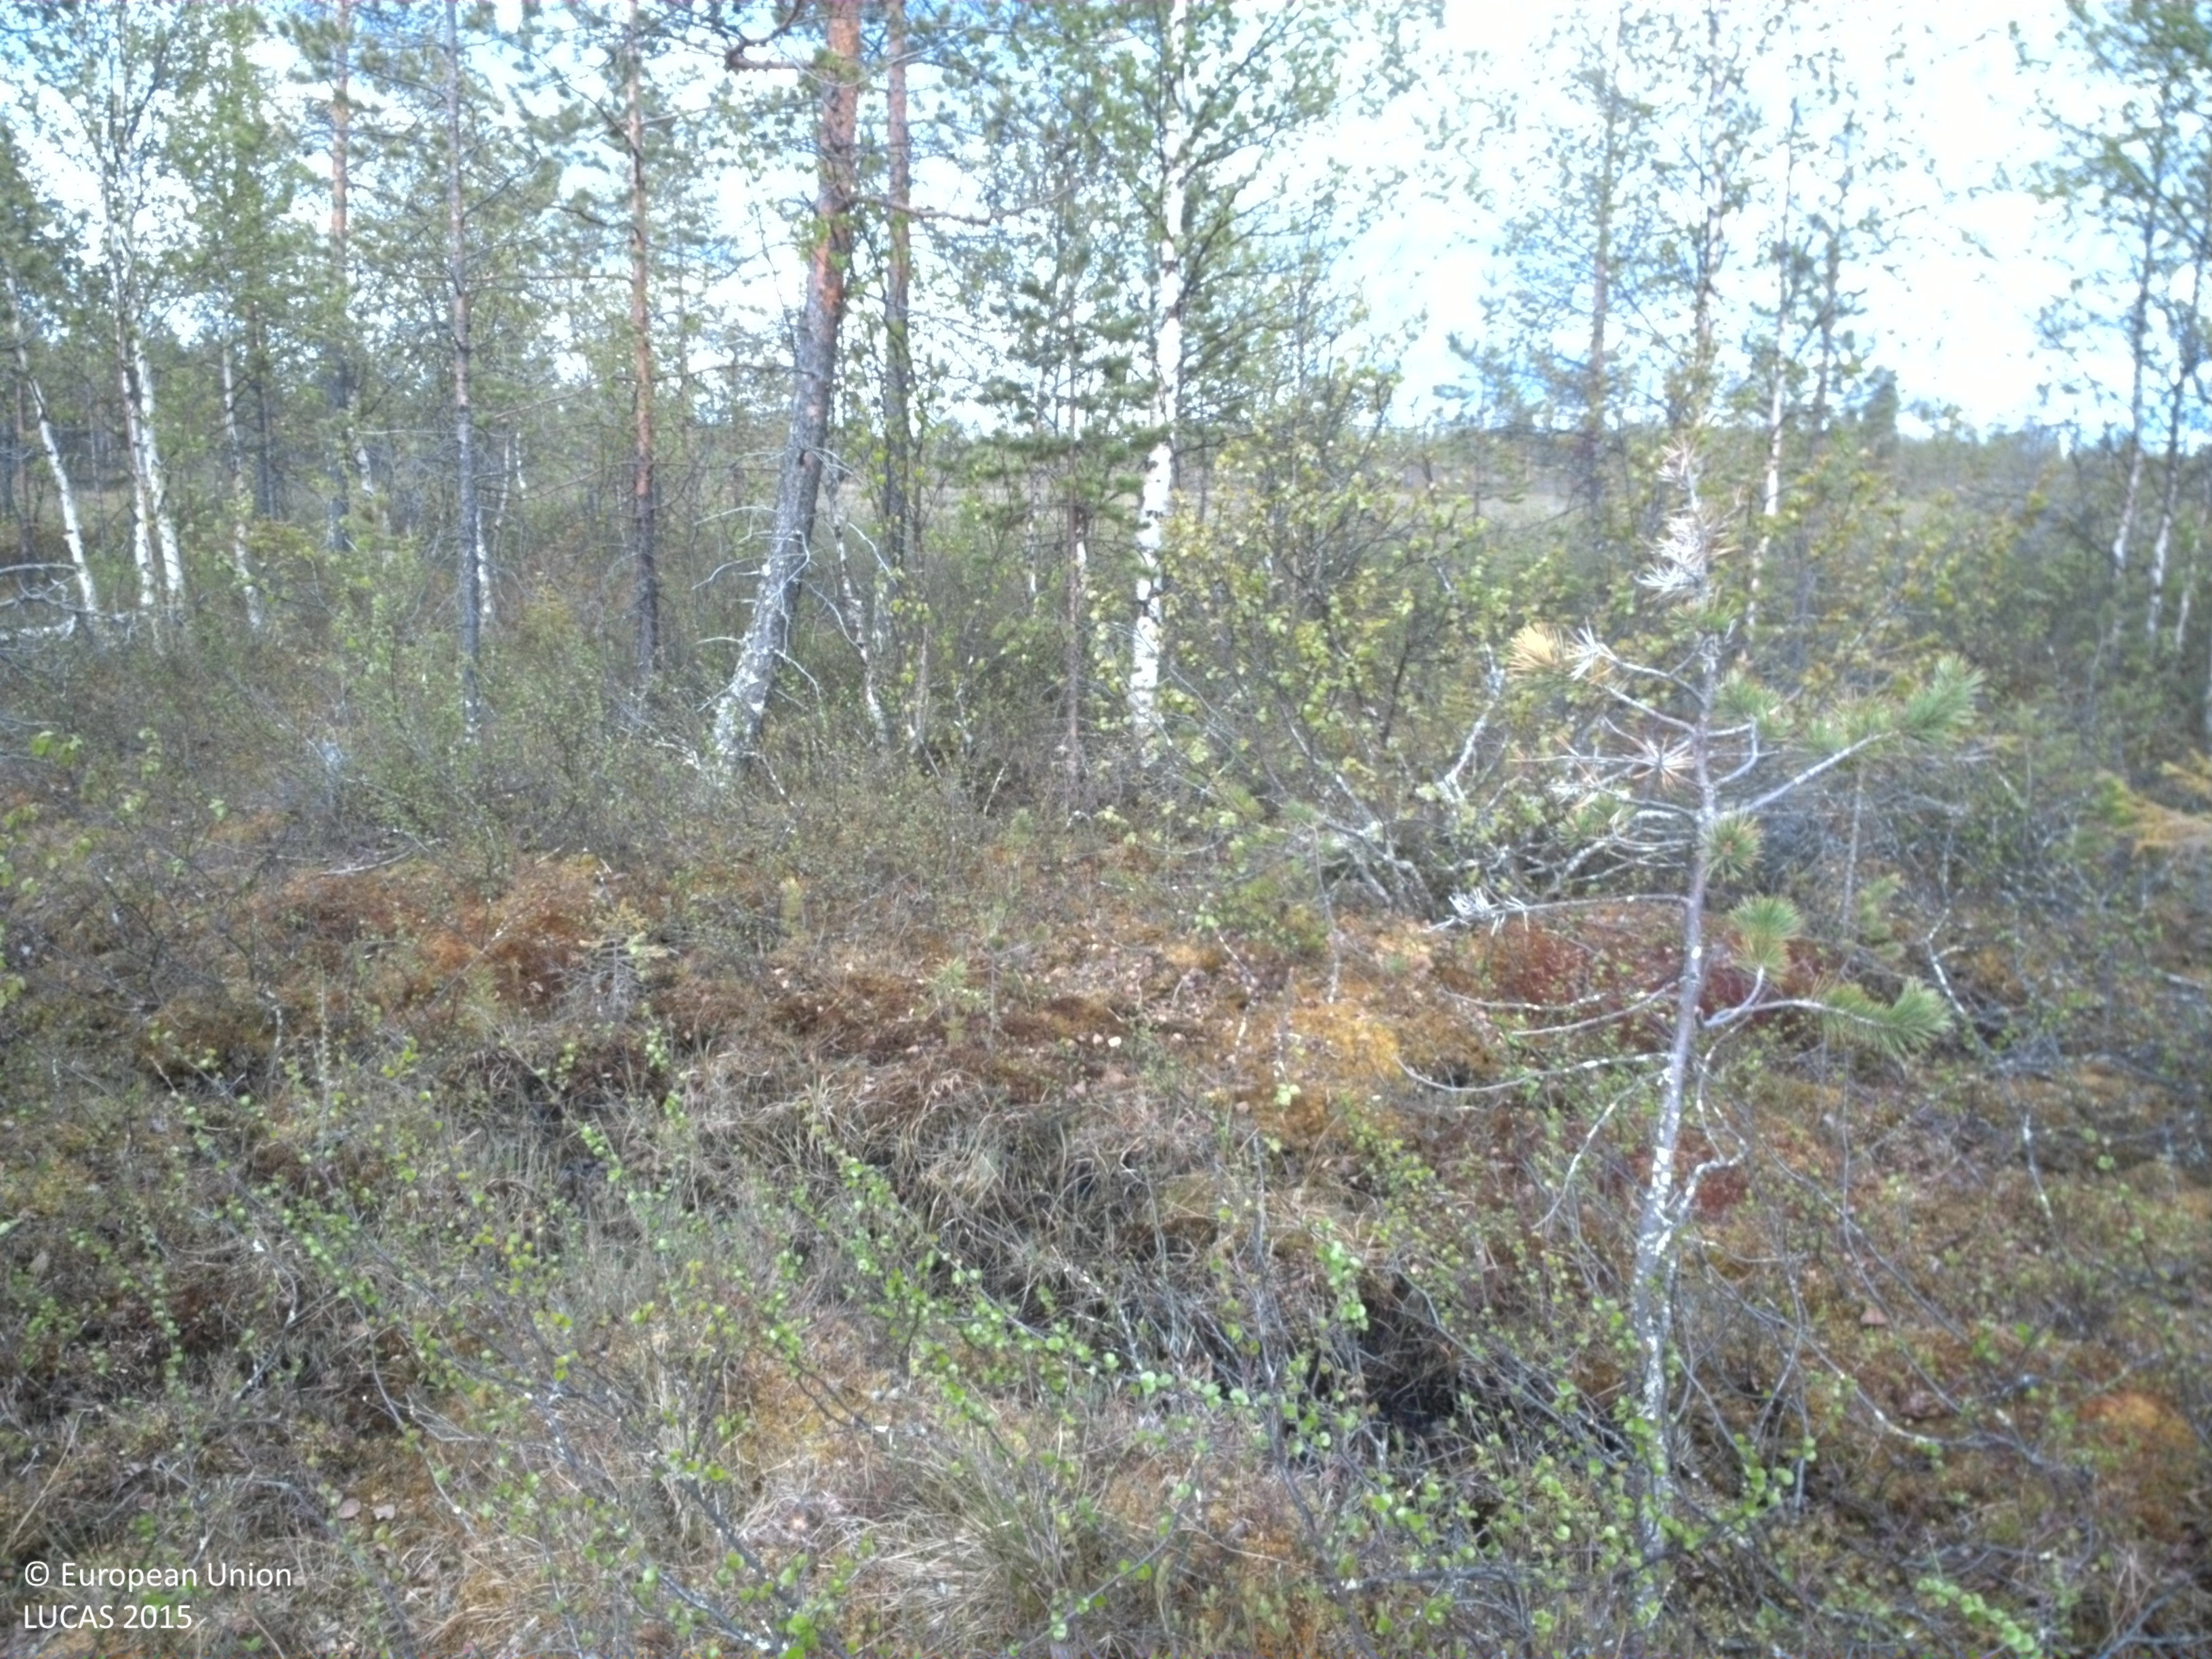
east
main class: Woodland
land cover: Pine dominated mixed woodland
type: boreal forest
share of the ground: 10 - 25 %
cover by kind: shrubs 65 %, coniferous forest trees 15 %, lichens and mosses 10 %, broadleaved forest trees 5 %, herbaceous plants 5 %
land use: Semi-natural and natural areas not in use
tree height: > 5 m
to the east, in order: Pine dominated mixed woodland; Shrubland with sparse tree cover; Peatbogs; Pine dominated mixed woodland
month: June
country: SE
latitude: 66.9152
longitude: 21.6833
